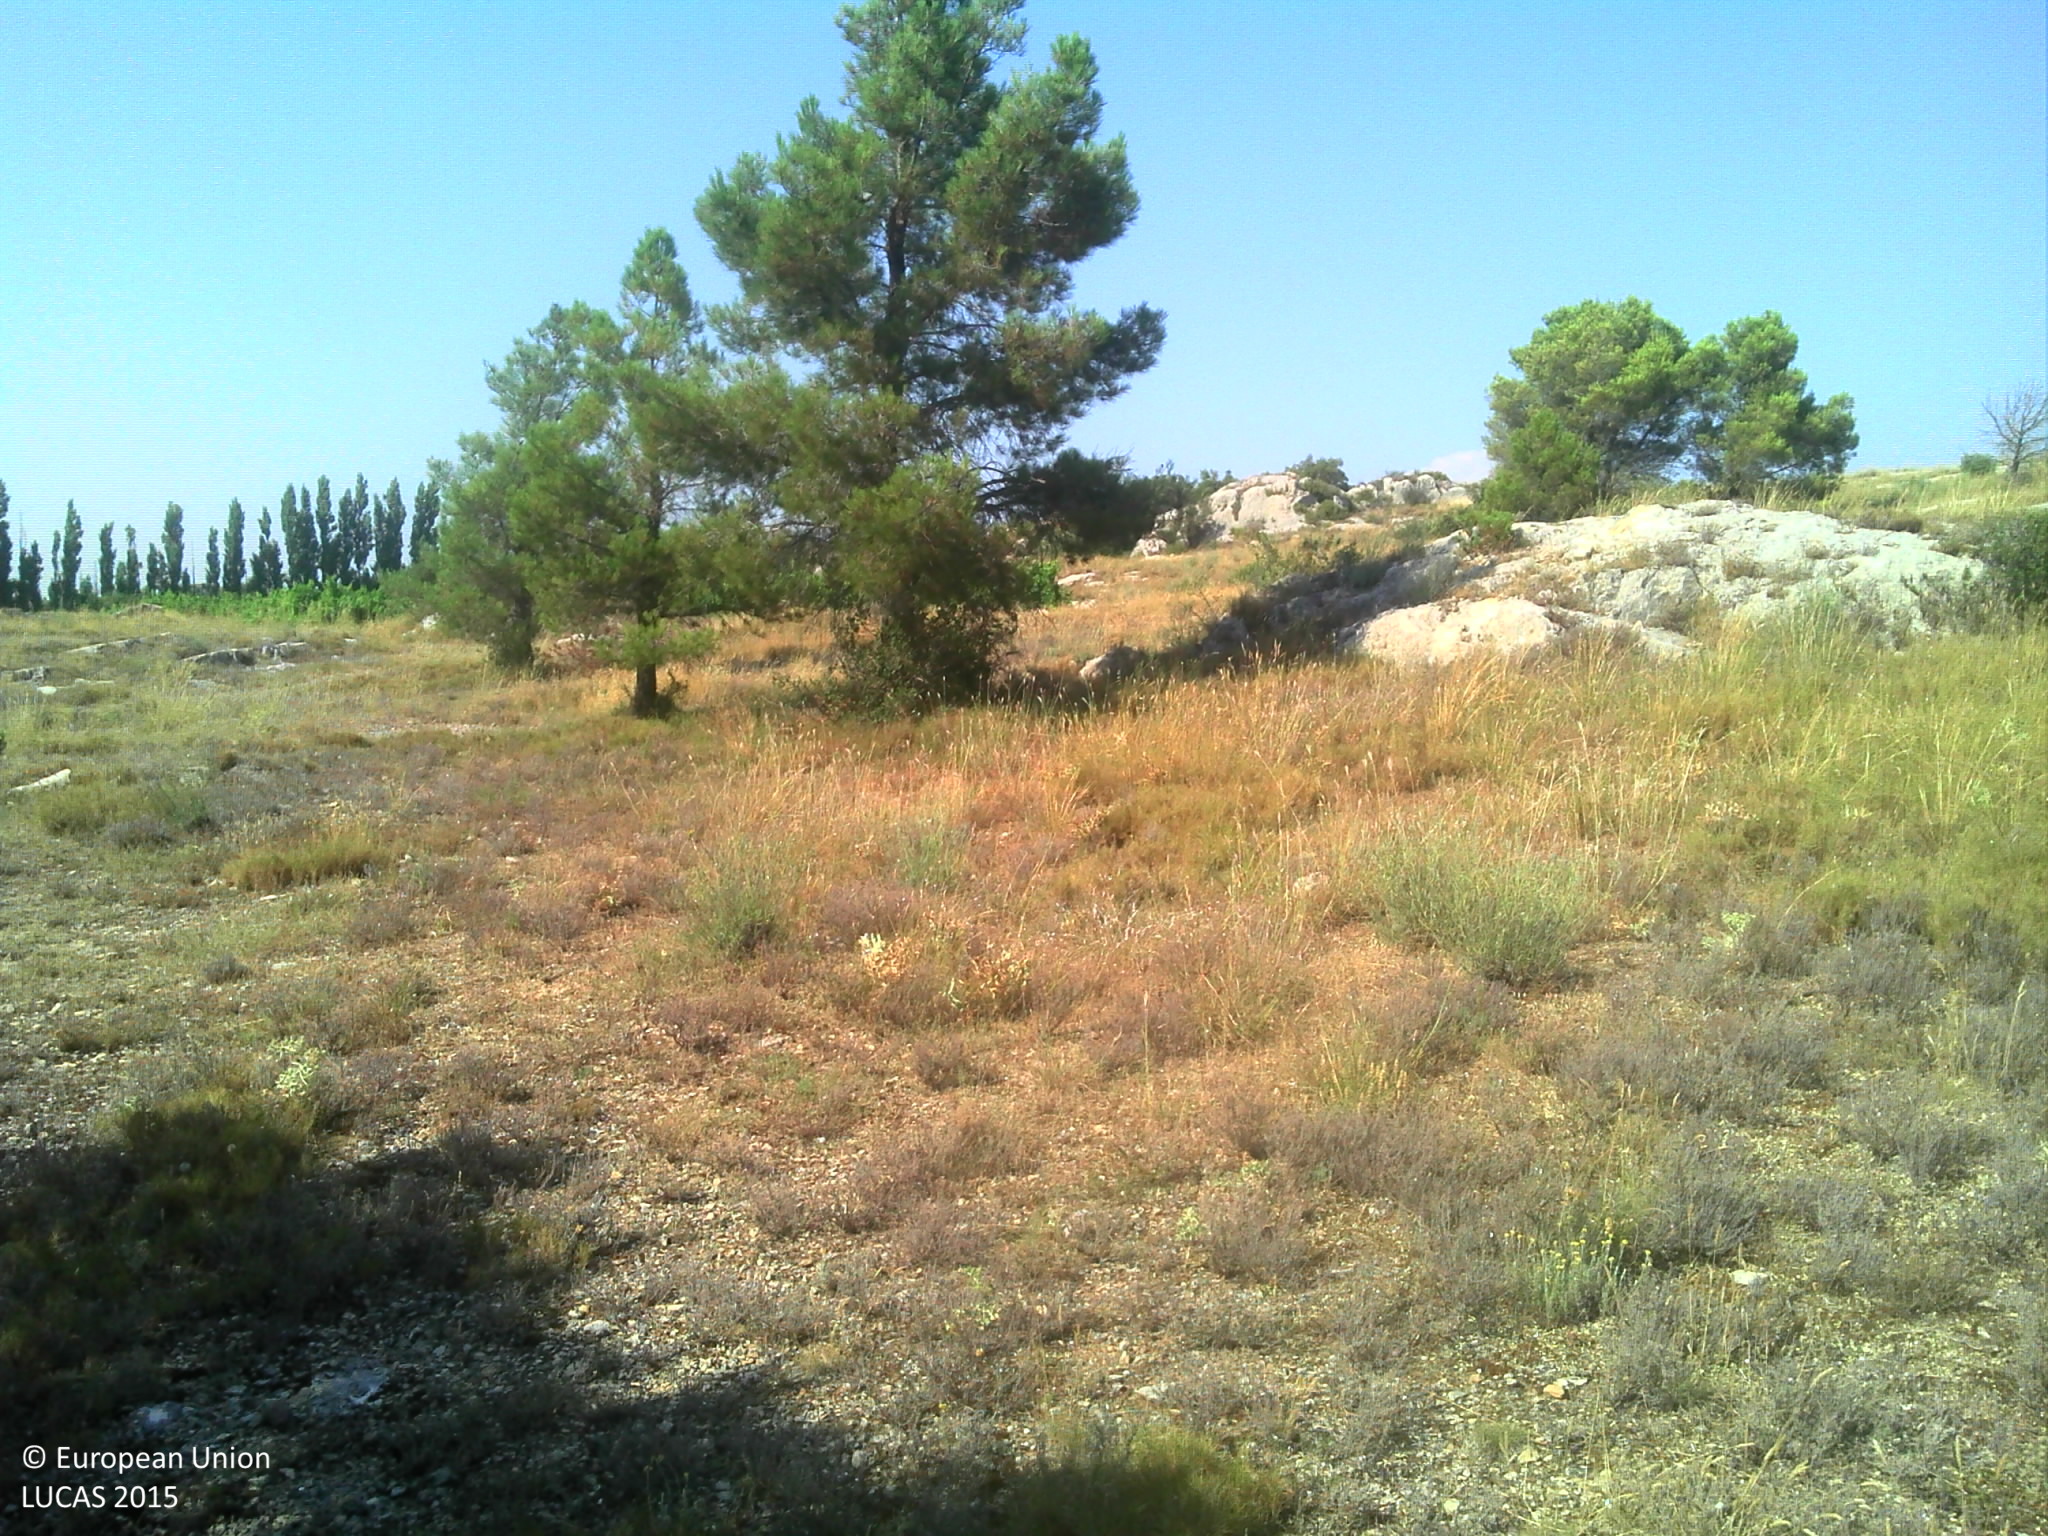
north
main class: Grassland
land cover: Grassland with sparse tree/shrub cover
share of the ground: 50 - 75 %
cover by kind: herbaceous plants 40 %, unconsolidated bare surface 40 %, lichens and mosses 10 %, broadleaved forest trees 5 %, shrubs 5 %
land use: Semi-natural and natural areas not in use
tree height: > 5 m
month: July
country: FR
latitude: 43.7291
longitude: 5.1055
